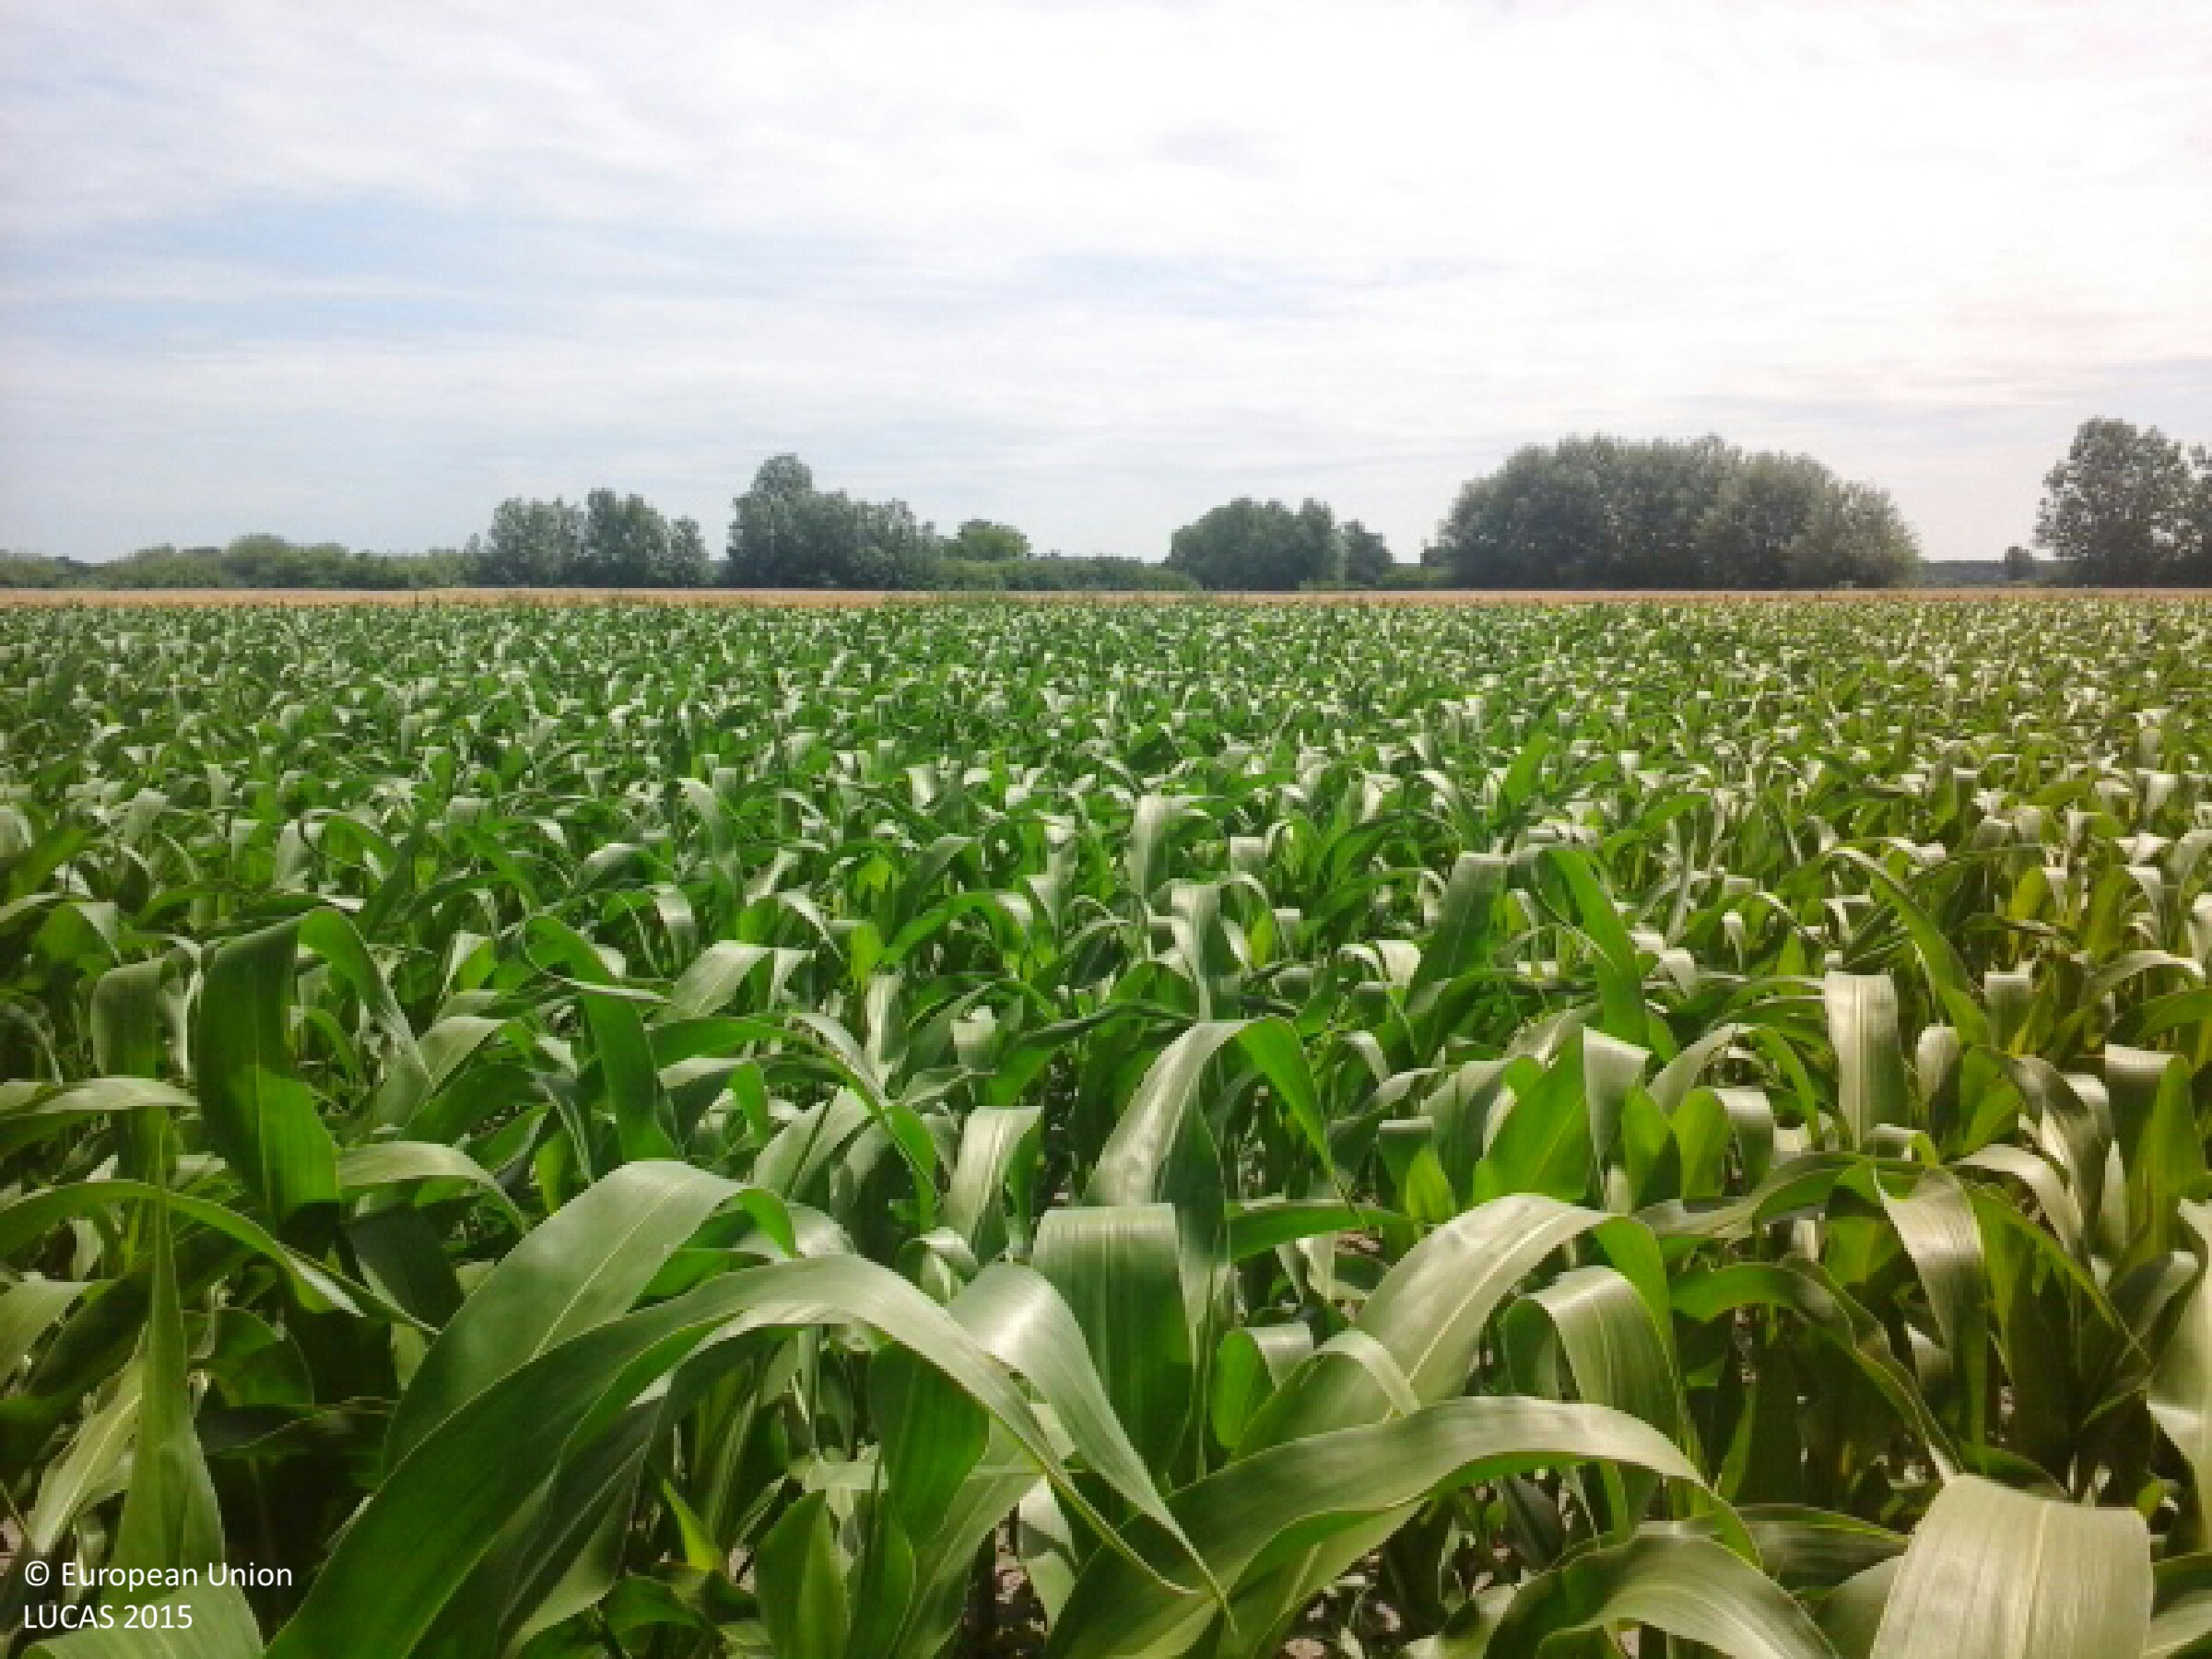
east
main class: Cropland
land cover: Maize
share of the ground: > 75 %
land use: Agriculture (excluding fallow land and kitchen gardens)
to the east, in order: Maize; Ditches and canals; Common wheat; Tracks; Shrubland with sparse tree cover; Triticale
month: June
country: HU
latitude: 48.0083
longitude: 21.9412
